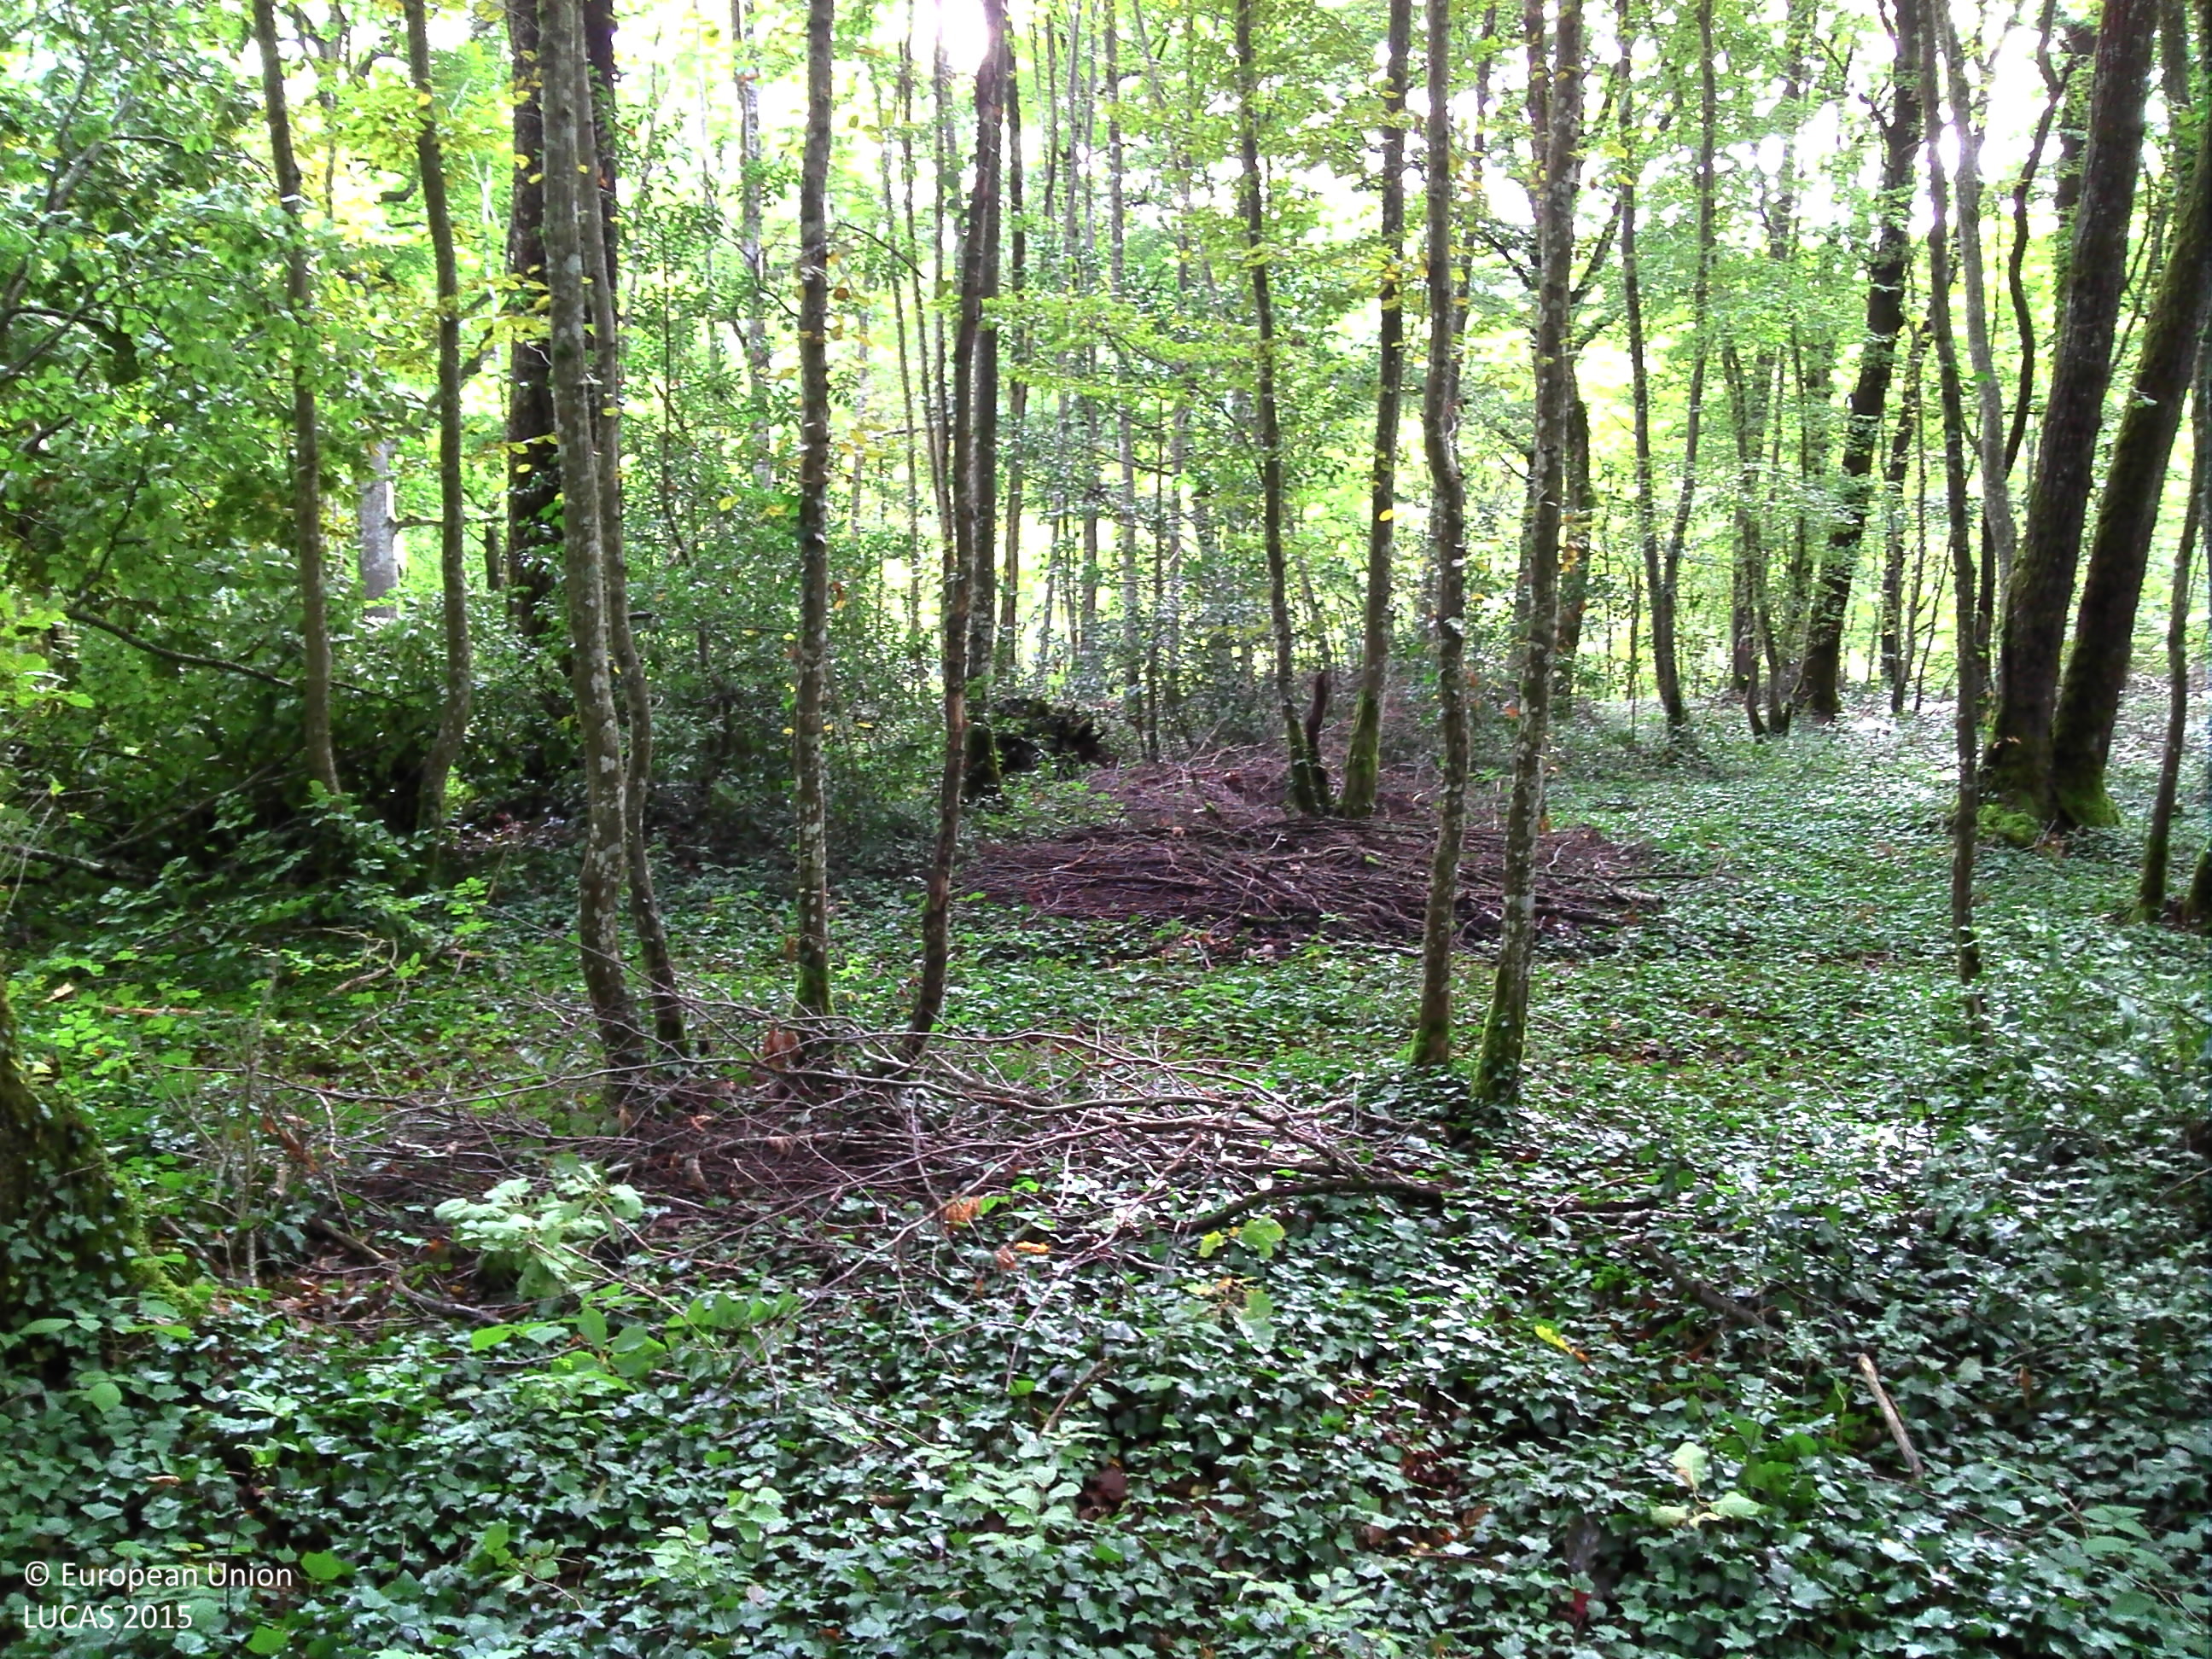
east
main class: Woodland
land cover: Broadleaved woodland
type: mesophytic deciduous forest
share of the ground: > 75 %
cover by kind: broadleaved forest trees 80 %, herbaceous plants 10 %, shrubs 5 %, lichens and mosses 5 %
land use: Forestry
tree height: > 5 m
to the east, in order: Broadleaved woodland; Other leguminous and mixtures for fodder; Grass margins; Abandoned hedges; Ditches and canals; Abandoned hedges; Spontaneously vegetated surfaces; Grass margins; Paved roads, cycling and walking lanes; Grass margins; Broadleaved woodland; Spruce dominated coniferous woodland
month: September
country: FR
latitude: 48.2996
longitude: 4.8082
